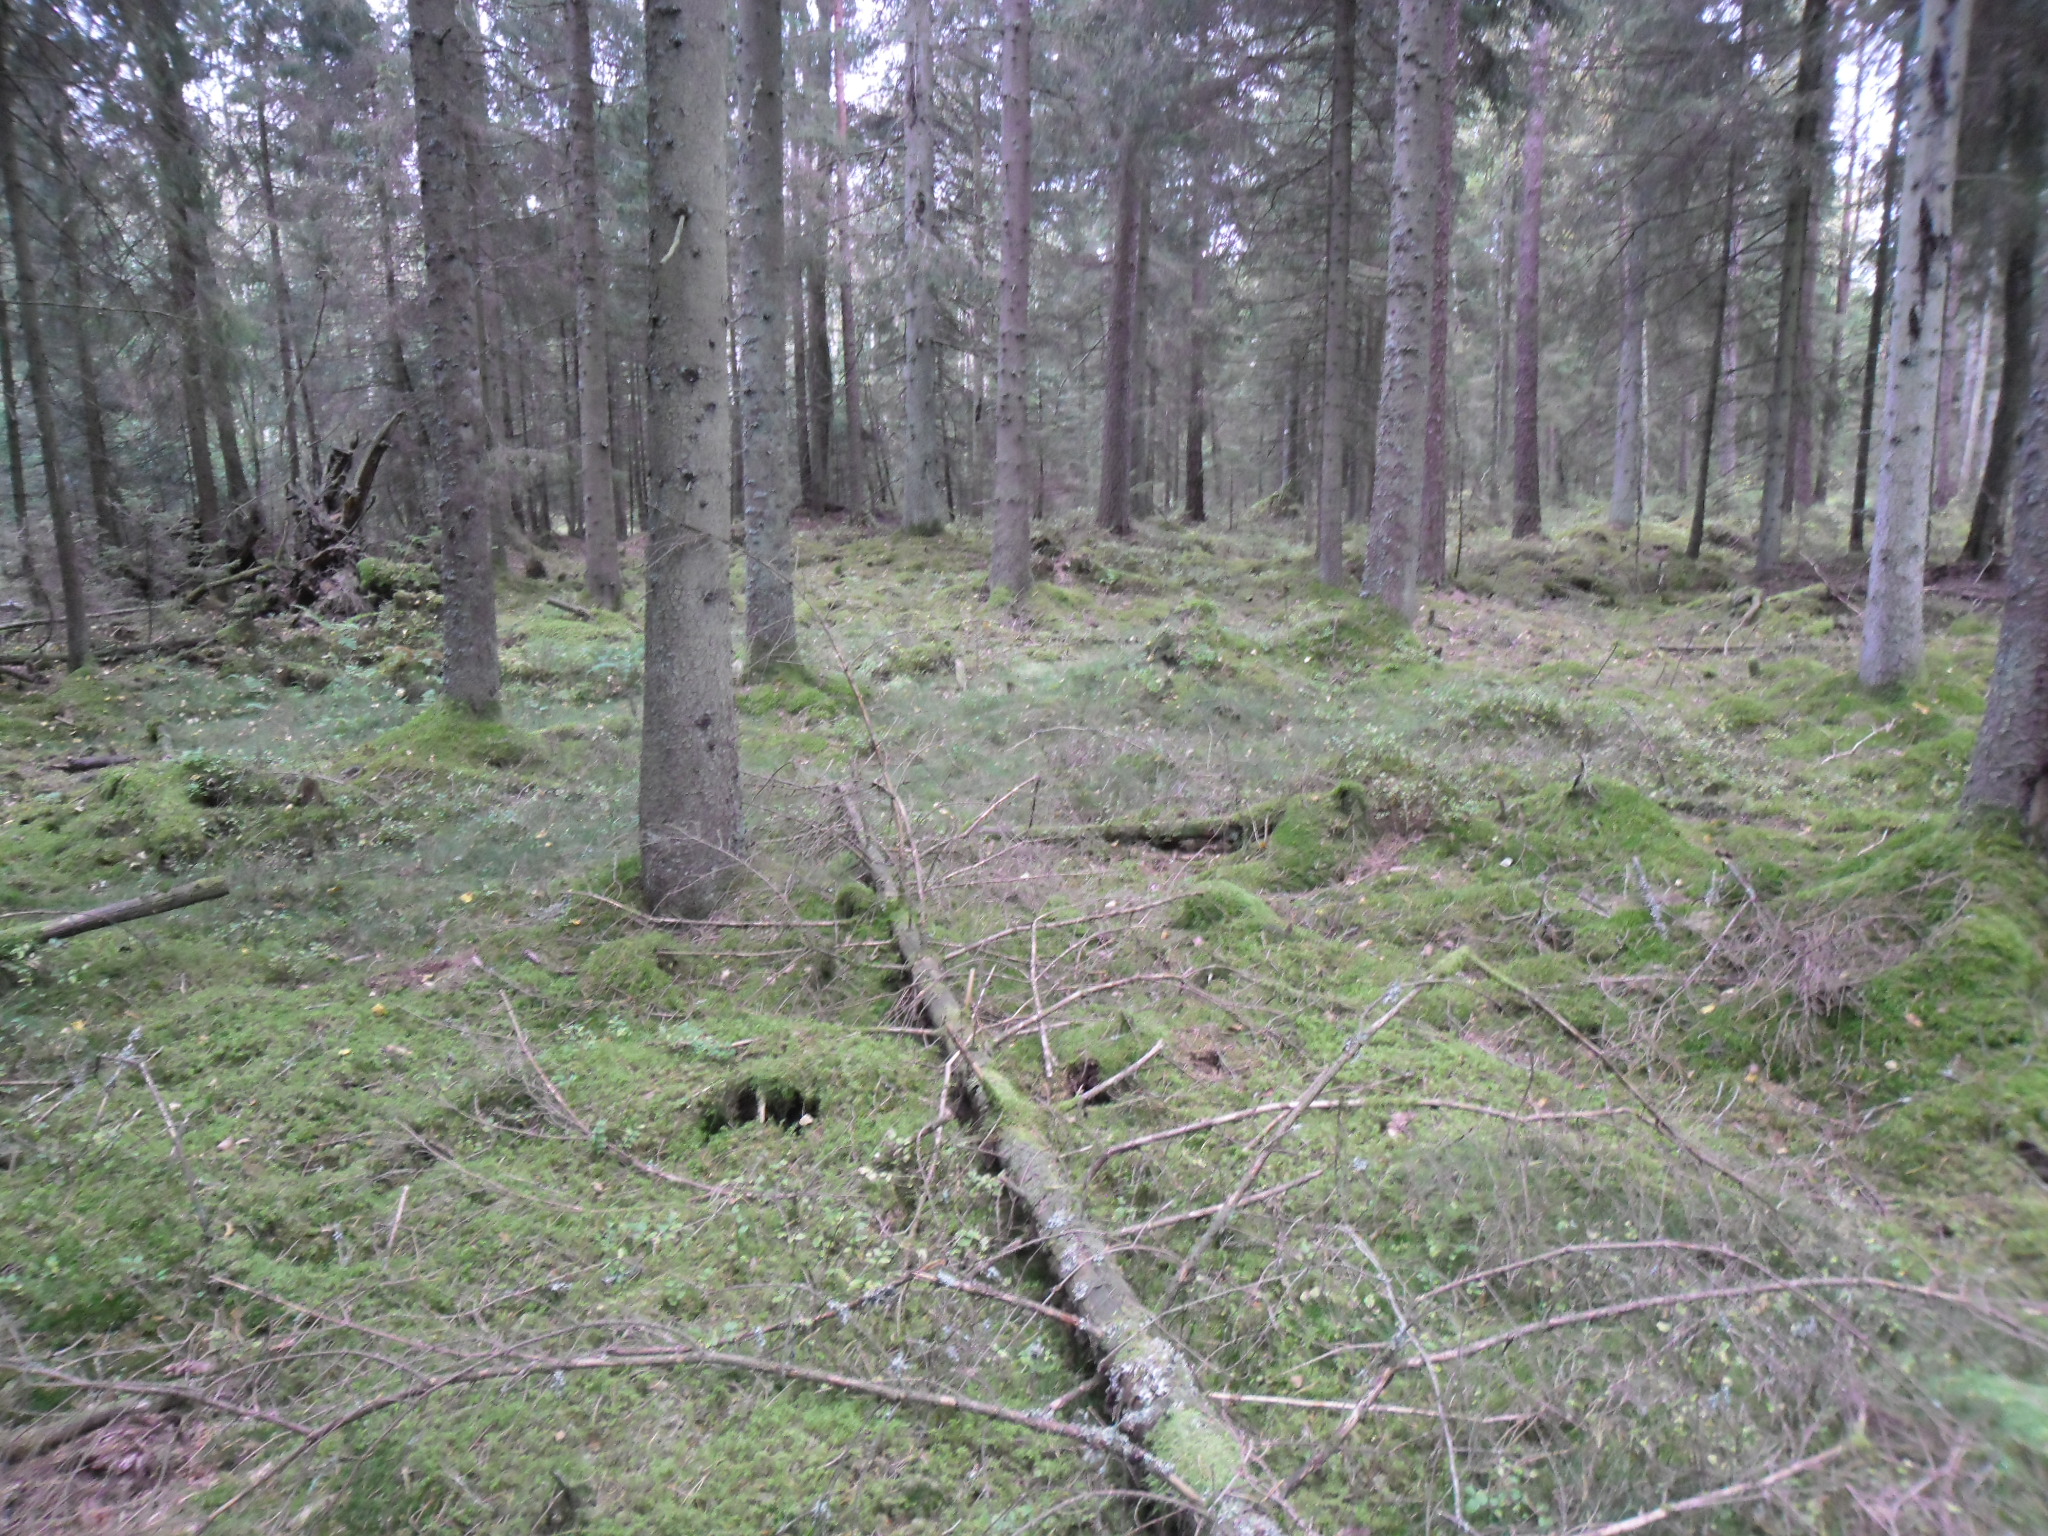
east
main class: Woodland
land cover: Spruce dominated coniferous woodland
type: boreal forest
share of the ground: > 75 %
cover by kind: coniferous forest trees 75 %, lichens and mosses 20 %, shrubs 5 %
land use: Forestry
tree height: > 5 m
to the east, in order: Spruce dominated coniferous woodland; Rivers and streams; Spruce dominated coniferous woodland; Paved roads, cycling and walking lanes; Spruce dominated coniferous woodland
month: October
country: SE
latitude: 56.4212
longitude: 13.7420
